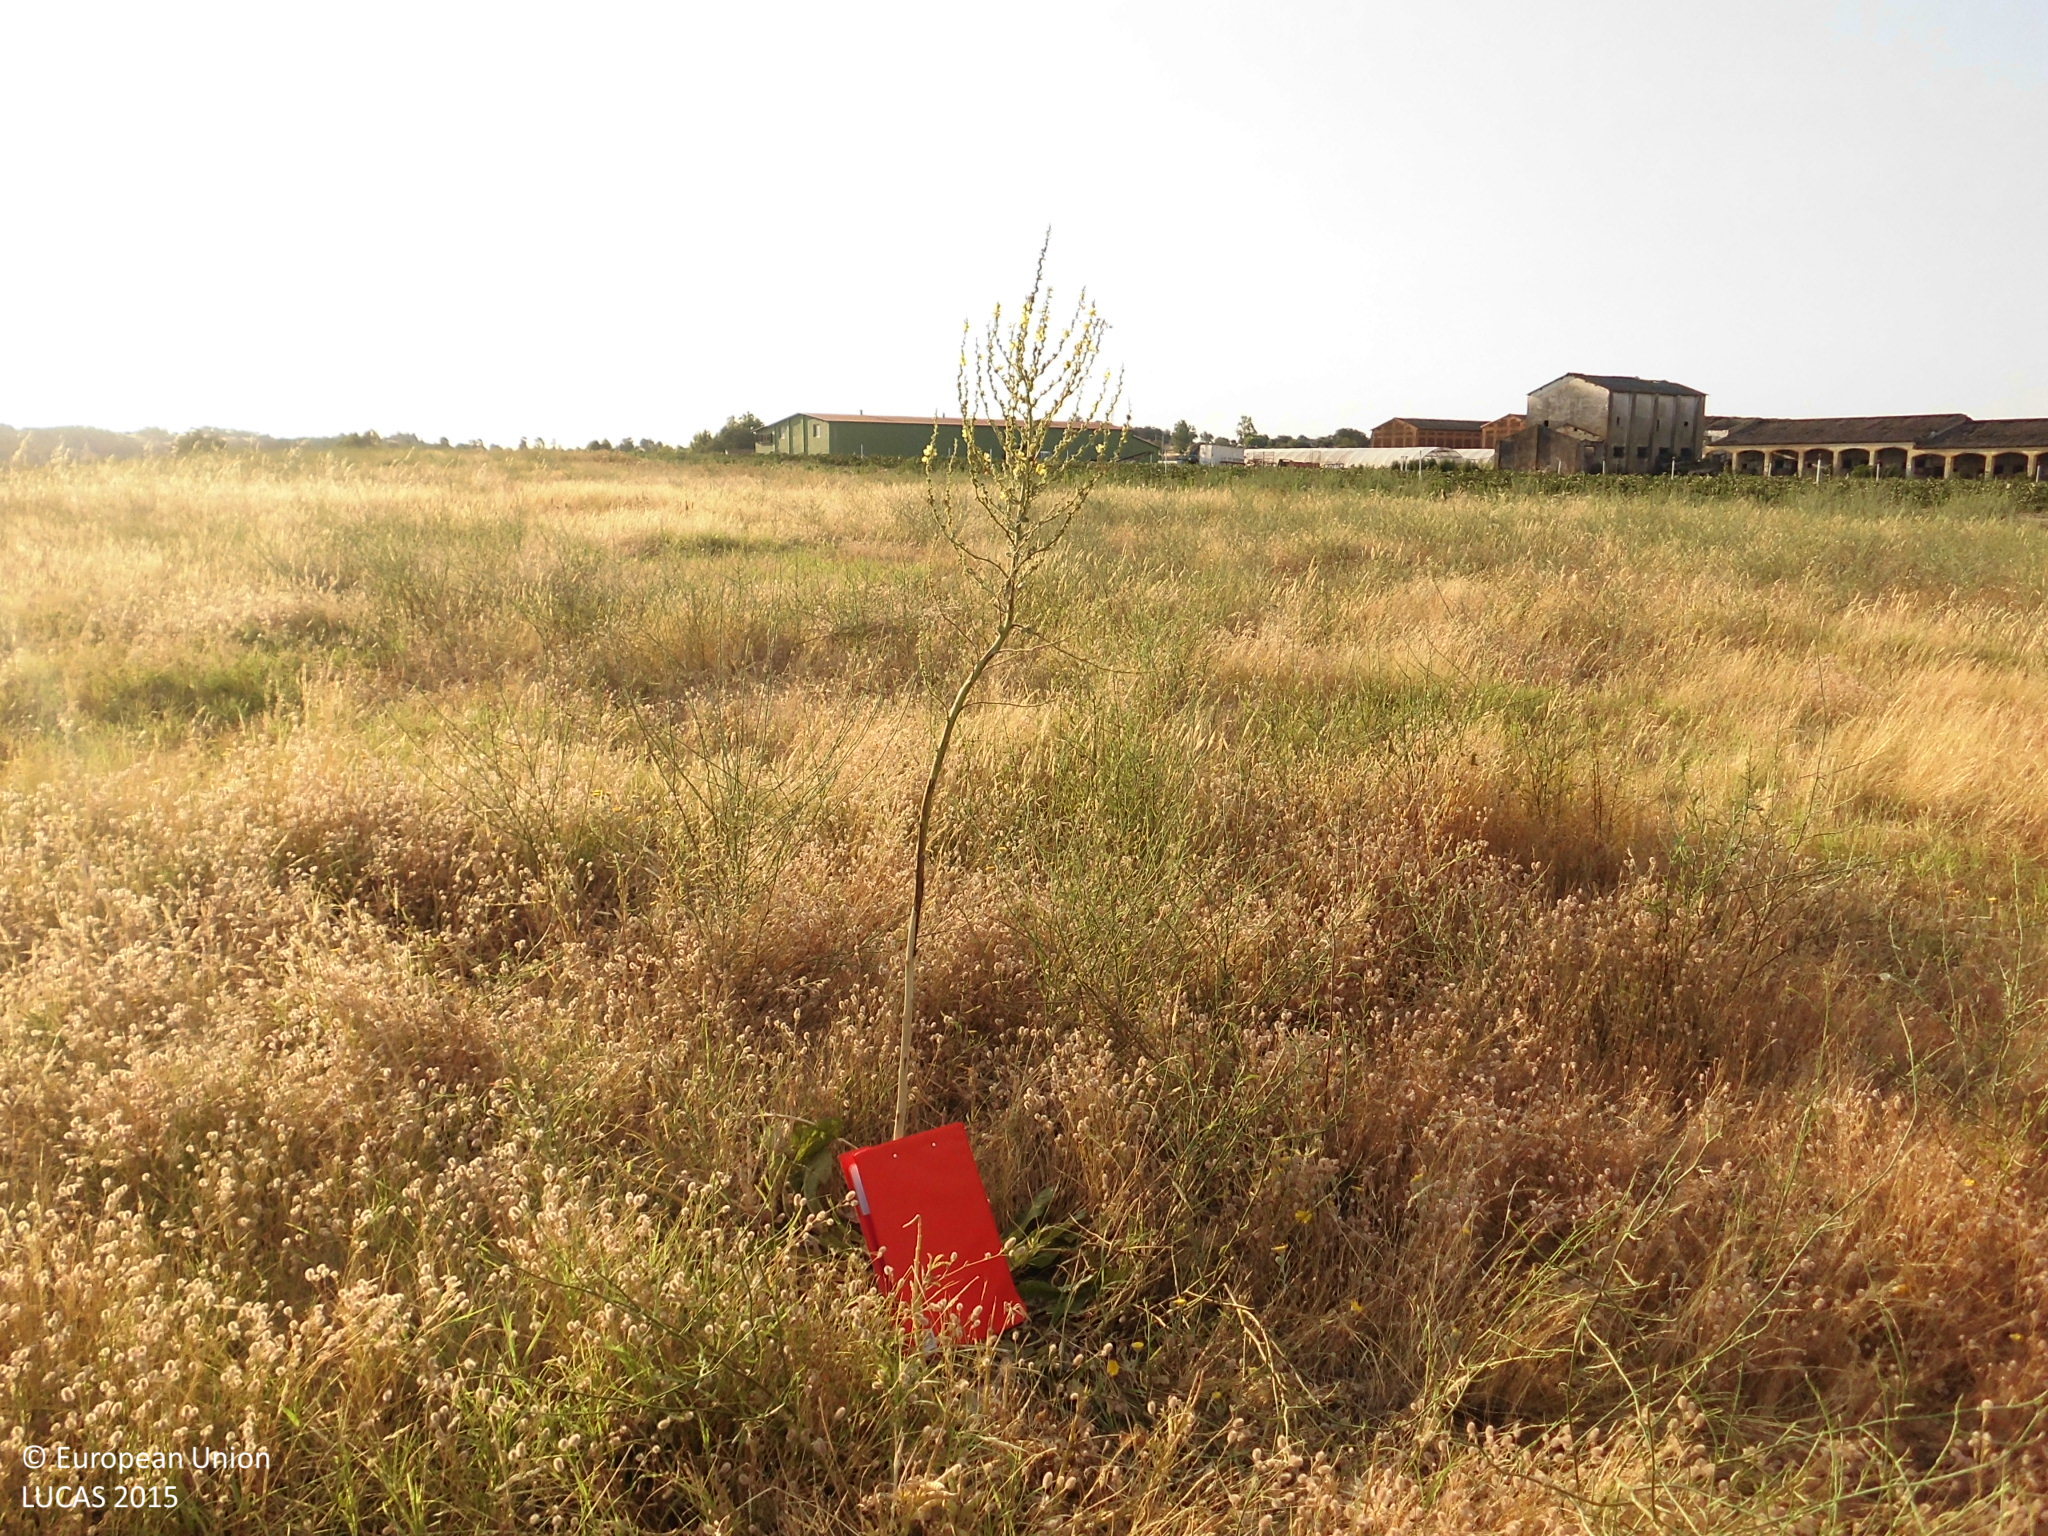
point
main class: Grassland
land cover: Spontaneously vegetated surfaces
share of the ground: > 75 %
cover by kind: herbaceous plants 100 %
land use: Fallow land
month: June
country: ES
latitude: 40.0639
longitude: -5.4538
